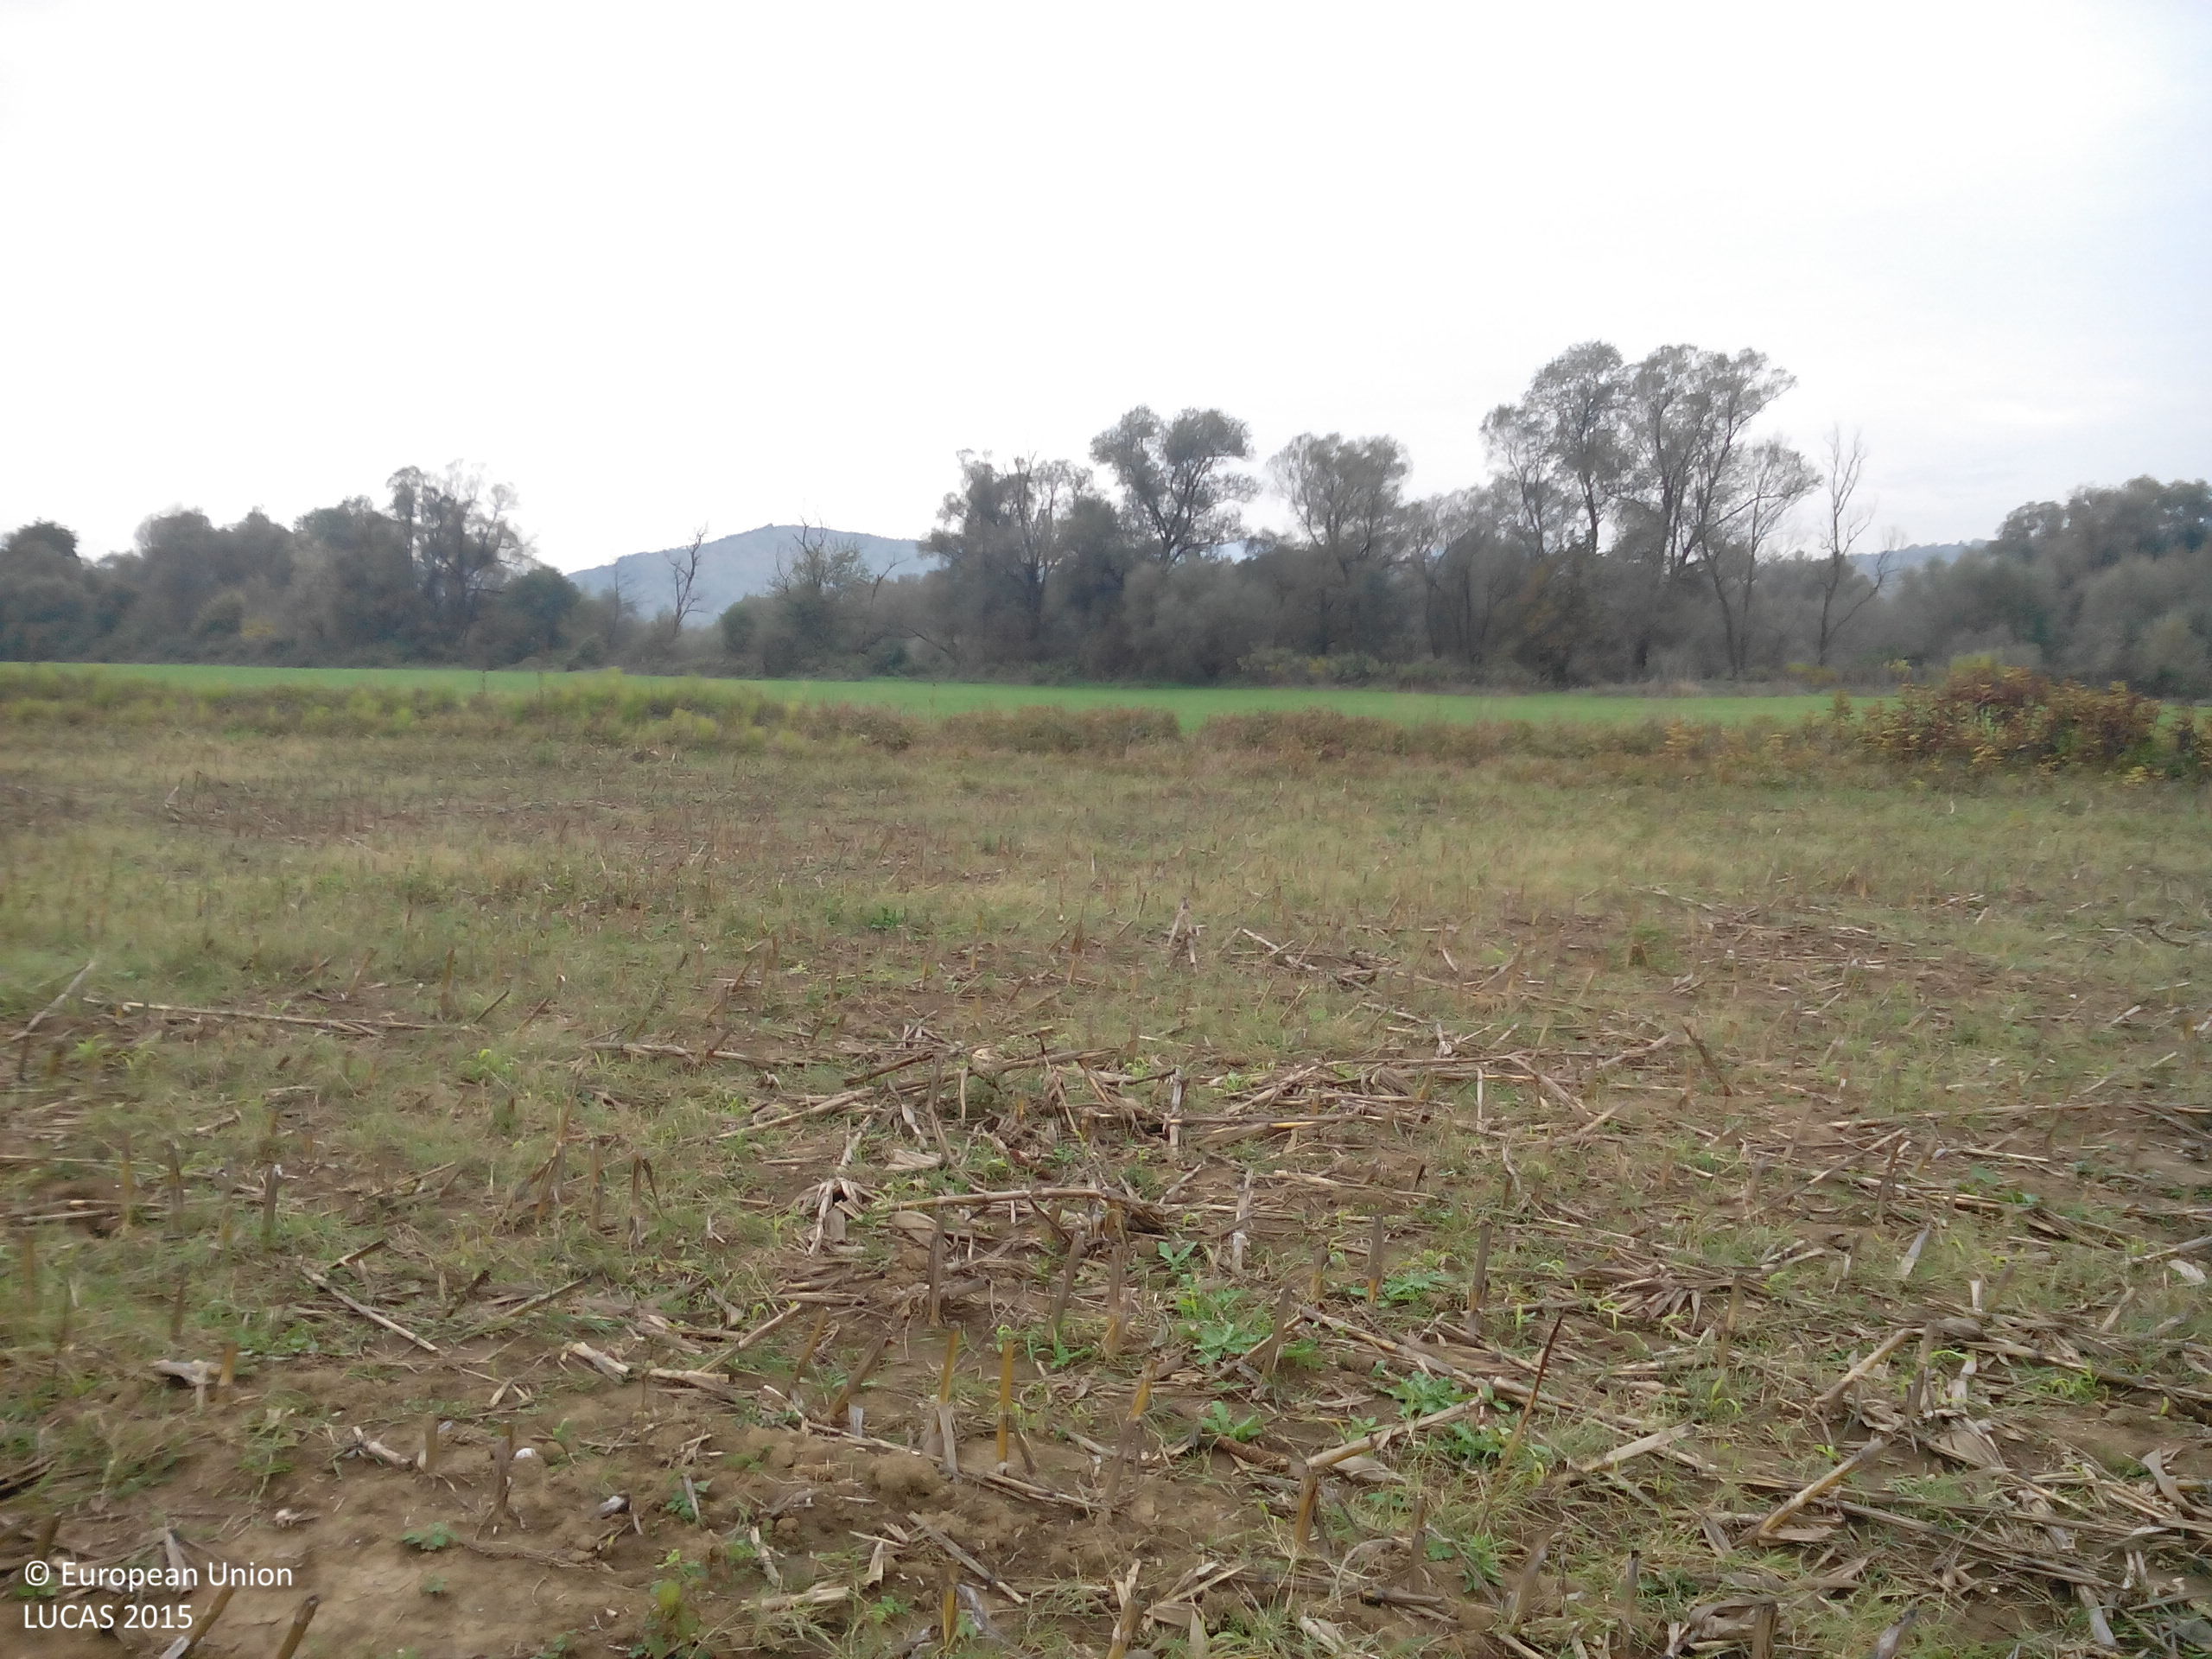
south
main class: Cropland
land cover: Maize
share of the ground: < 10 %
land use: Agriculture (excluding fallow land and kitchen gardens)
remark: Harvested field
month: October
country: BG
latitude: 42.9912
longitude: 24.0178
